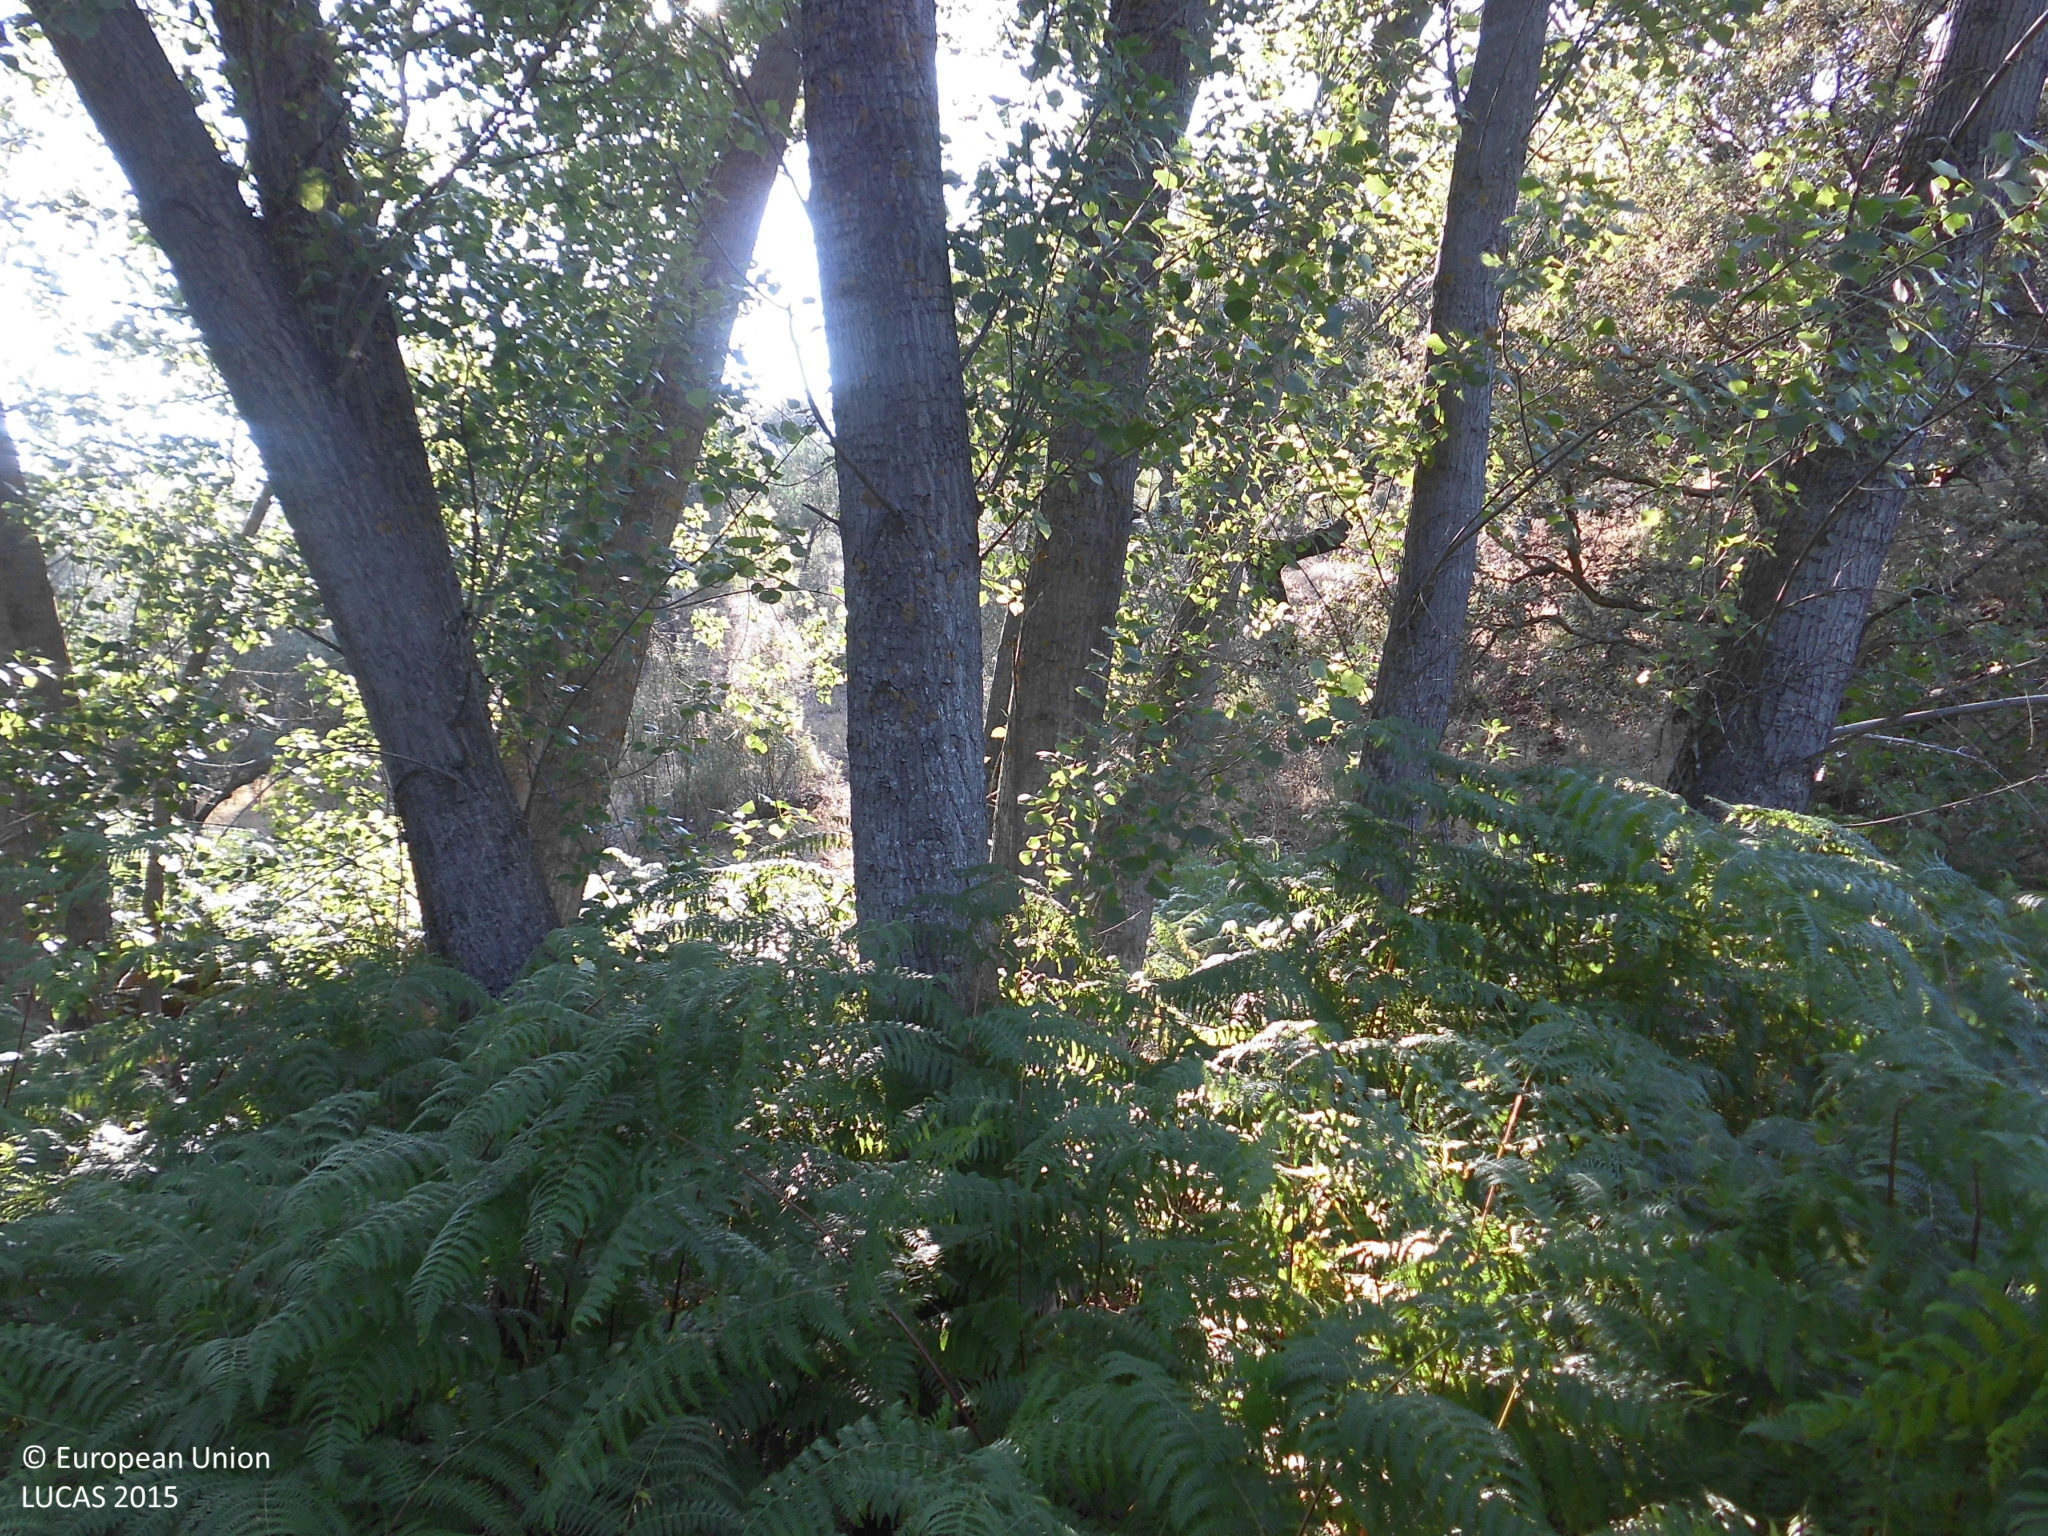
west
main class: Shrubland
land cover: Shrubland with sparse tree cover
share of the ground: > 75 %
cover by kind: shrubs 90 %, broadleaved forest trees 5 %, herbaceous plants 5 %
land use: Semi-natural and natural areas not in use
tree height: > 5 m
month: June
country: ES
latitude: 39.6534
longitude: -5.3780
